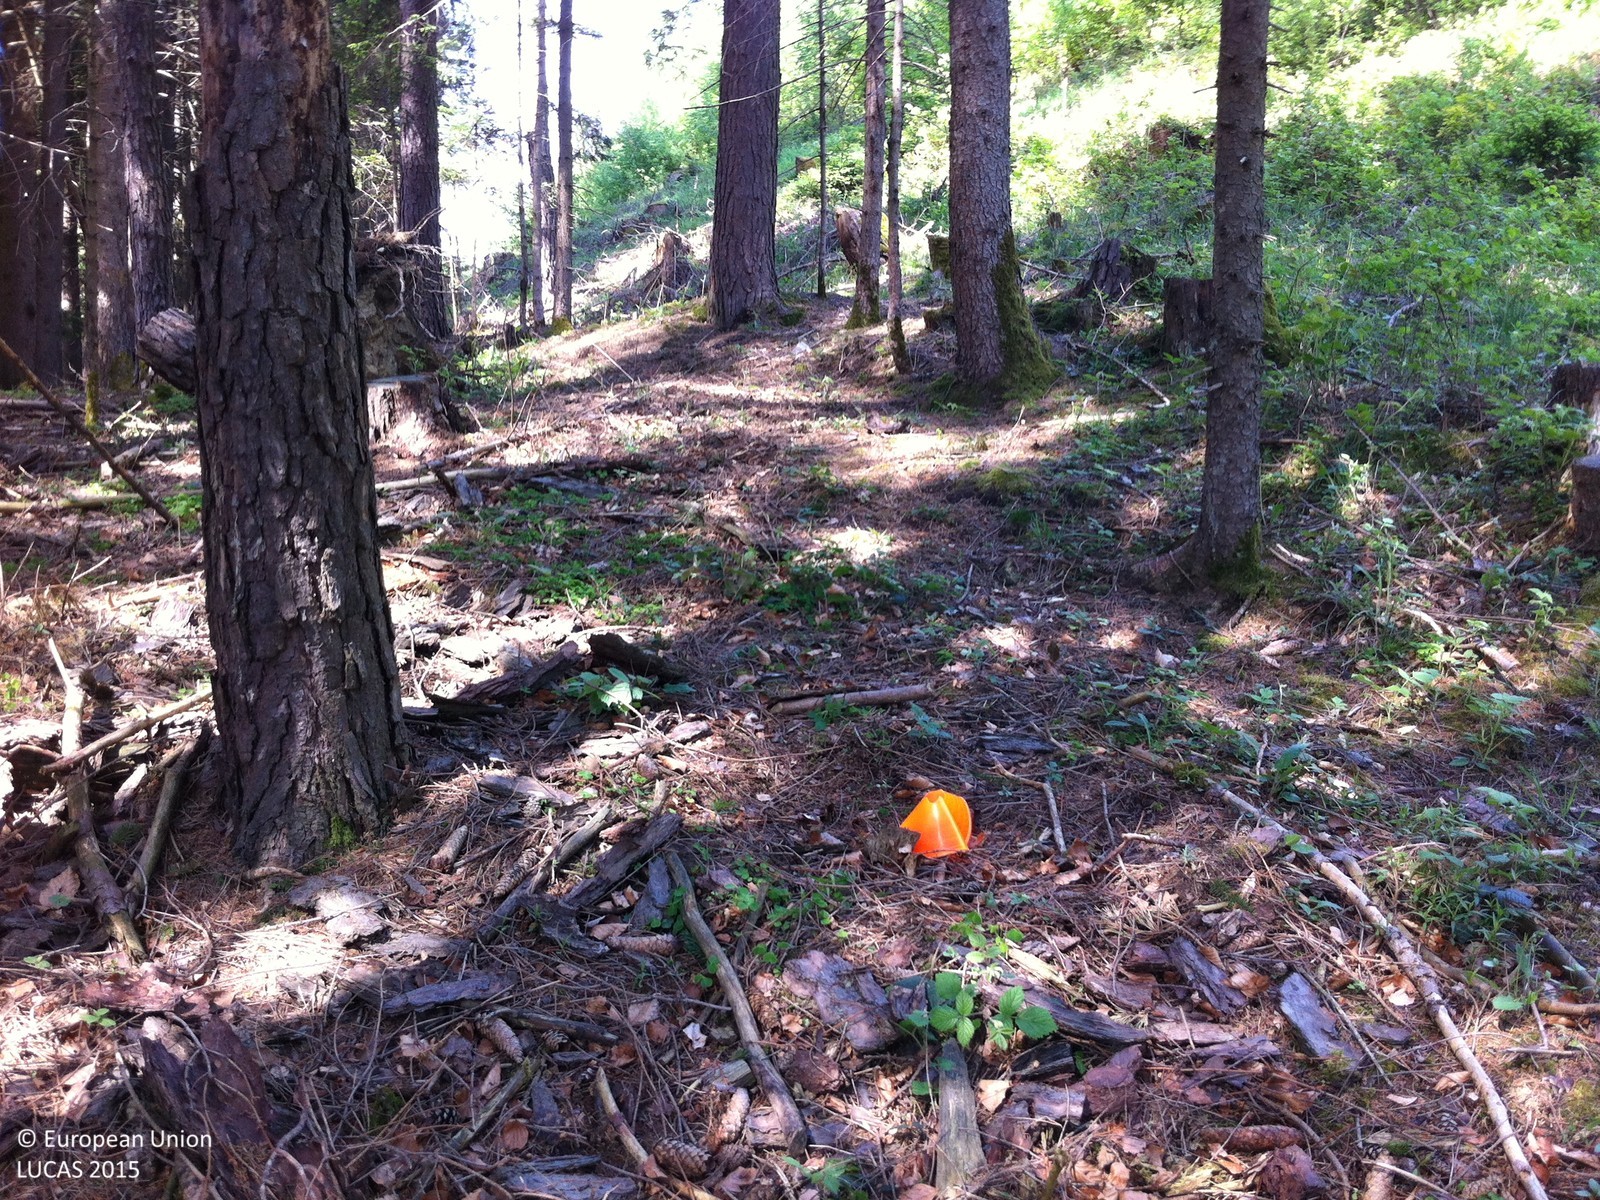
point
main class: Woodland
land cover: Spruce dominated coniferous woodland
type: alpine coniferous forest
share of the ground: > 75 %
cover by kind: coniferous forest trees 100 %
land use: Forestry
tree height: > 5 m
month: May
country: AT
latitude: 47.3466
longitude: 11.6797
